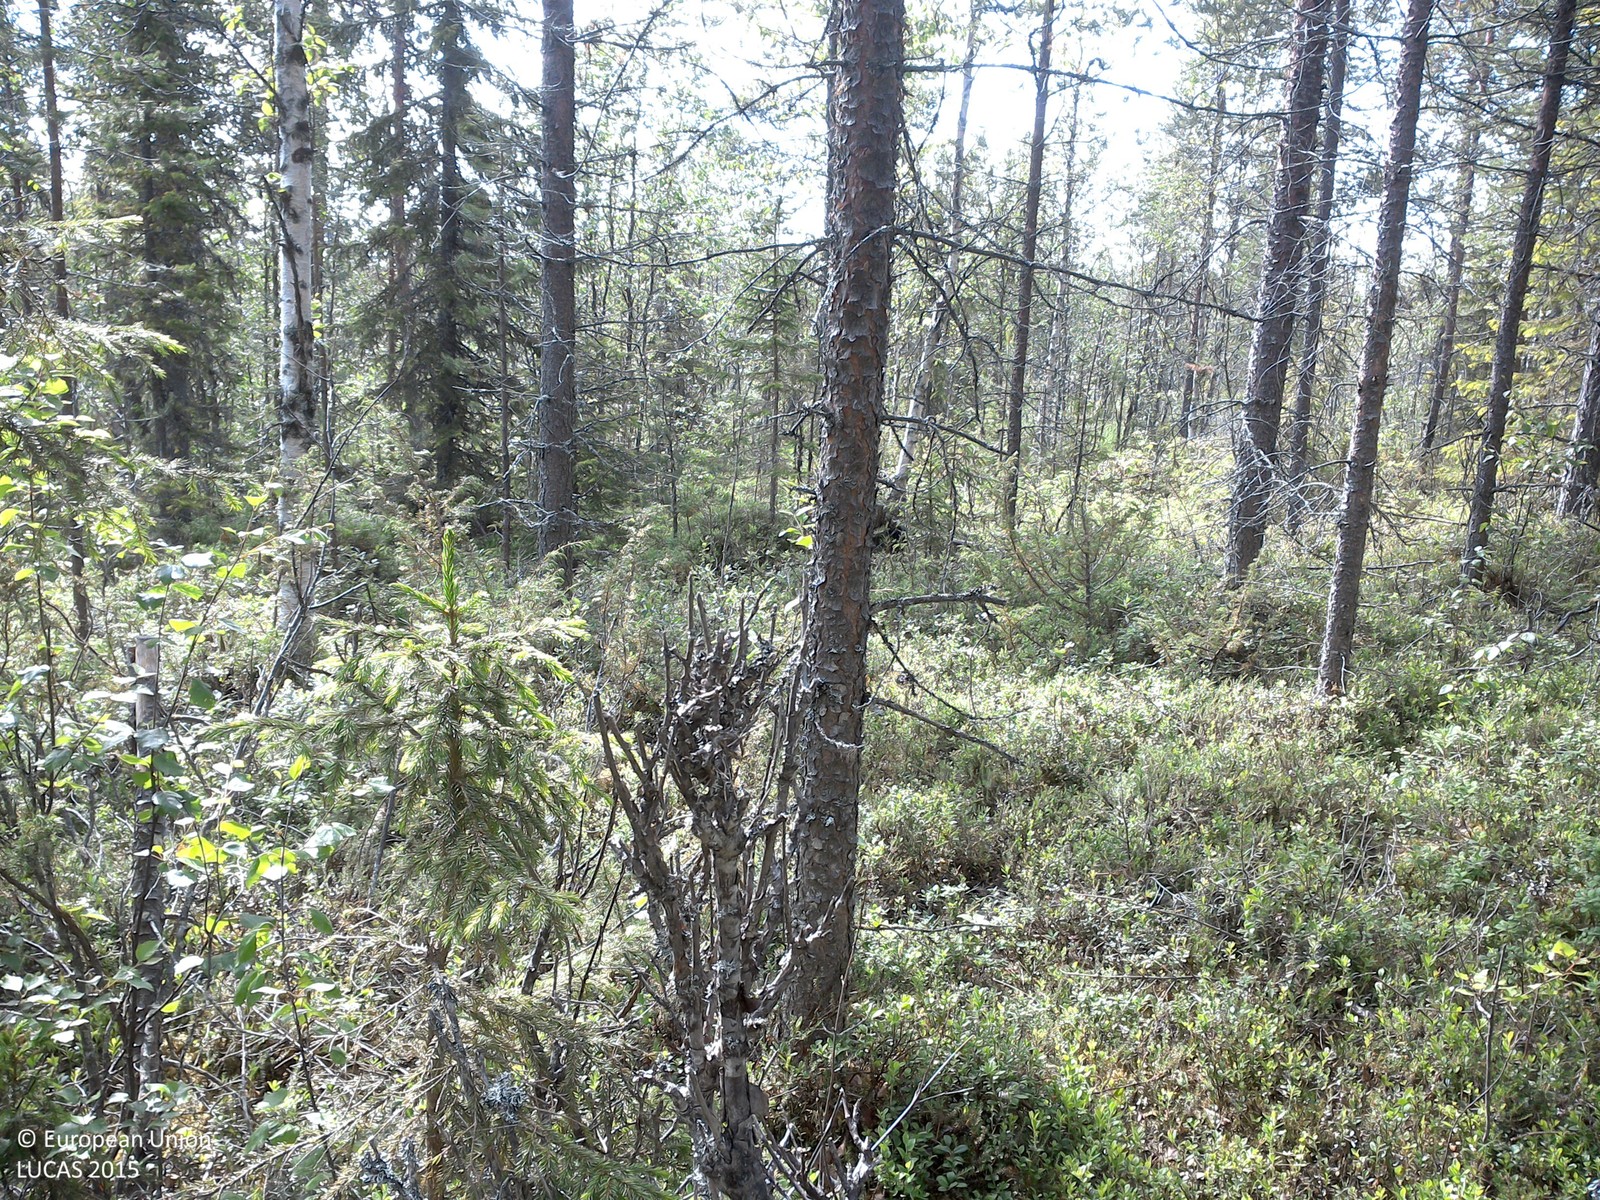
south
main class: Woodland
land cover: Pine dominated mixed woodland
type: boreal forest
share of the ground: 25 - 50 %
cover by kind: shrubs 65 %, coniferous forest trees 25 %, broadleaved forest trees 10 %
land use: Forestry
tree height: > 5 m
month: July
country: SE
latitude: 67.2154
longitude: 23.1352
